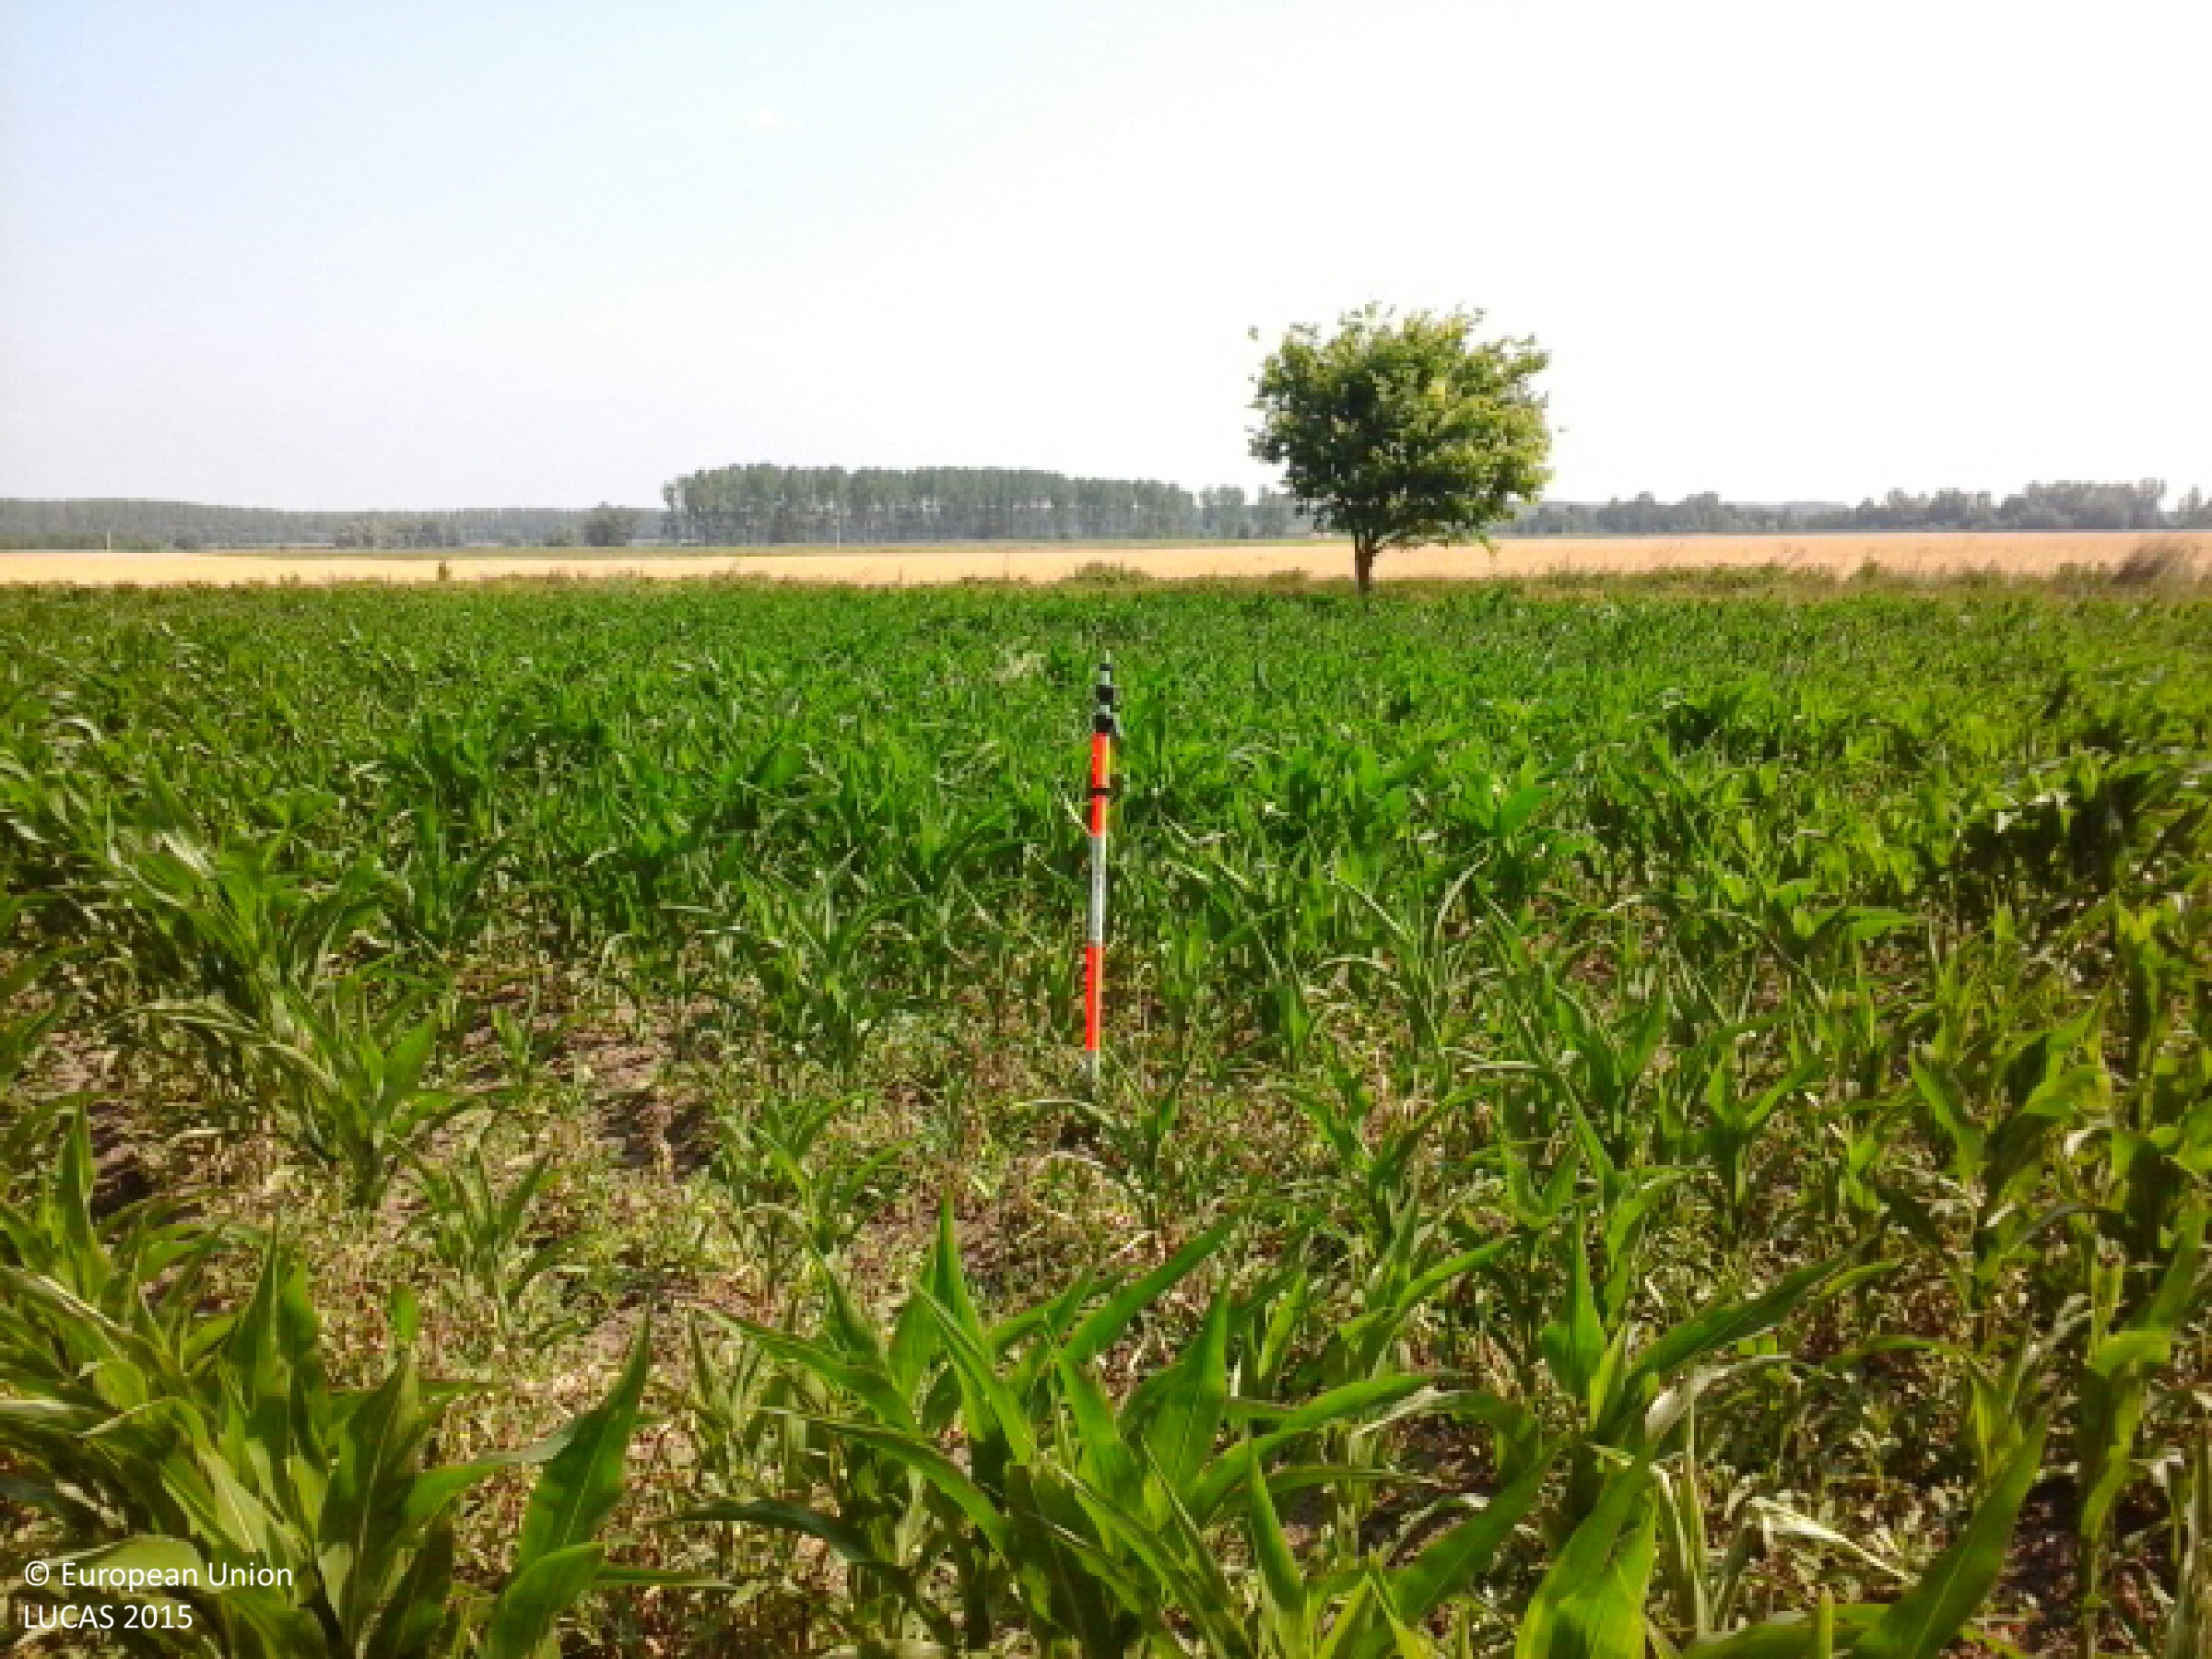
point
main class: Cropland
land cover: Maize
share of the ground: 50 - 75 %
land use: Agriculture (excluding fallow land and kitchen gardens)
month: June
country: HU
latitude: 48.2178
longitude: 21.8546
